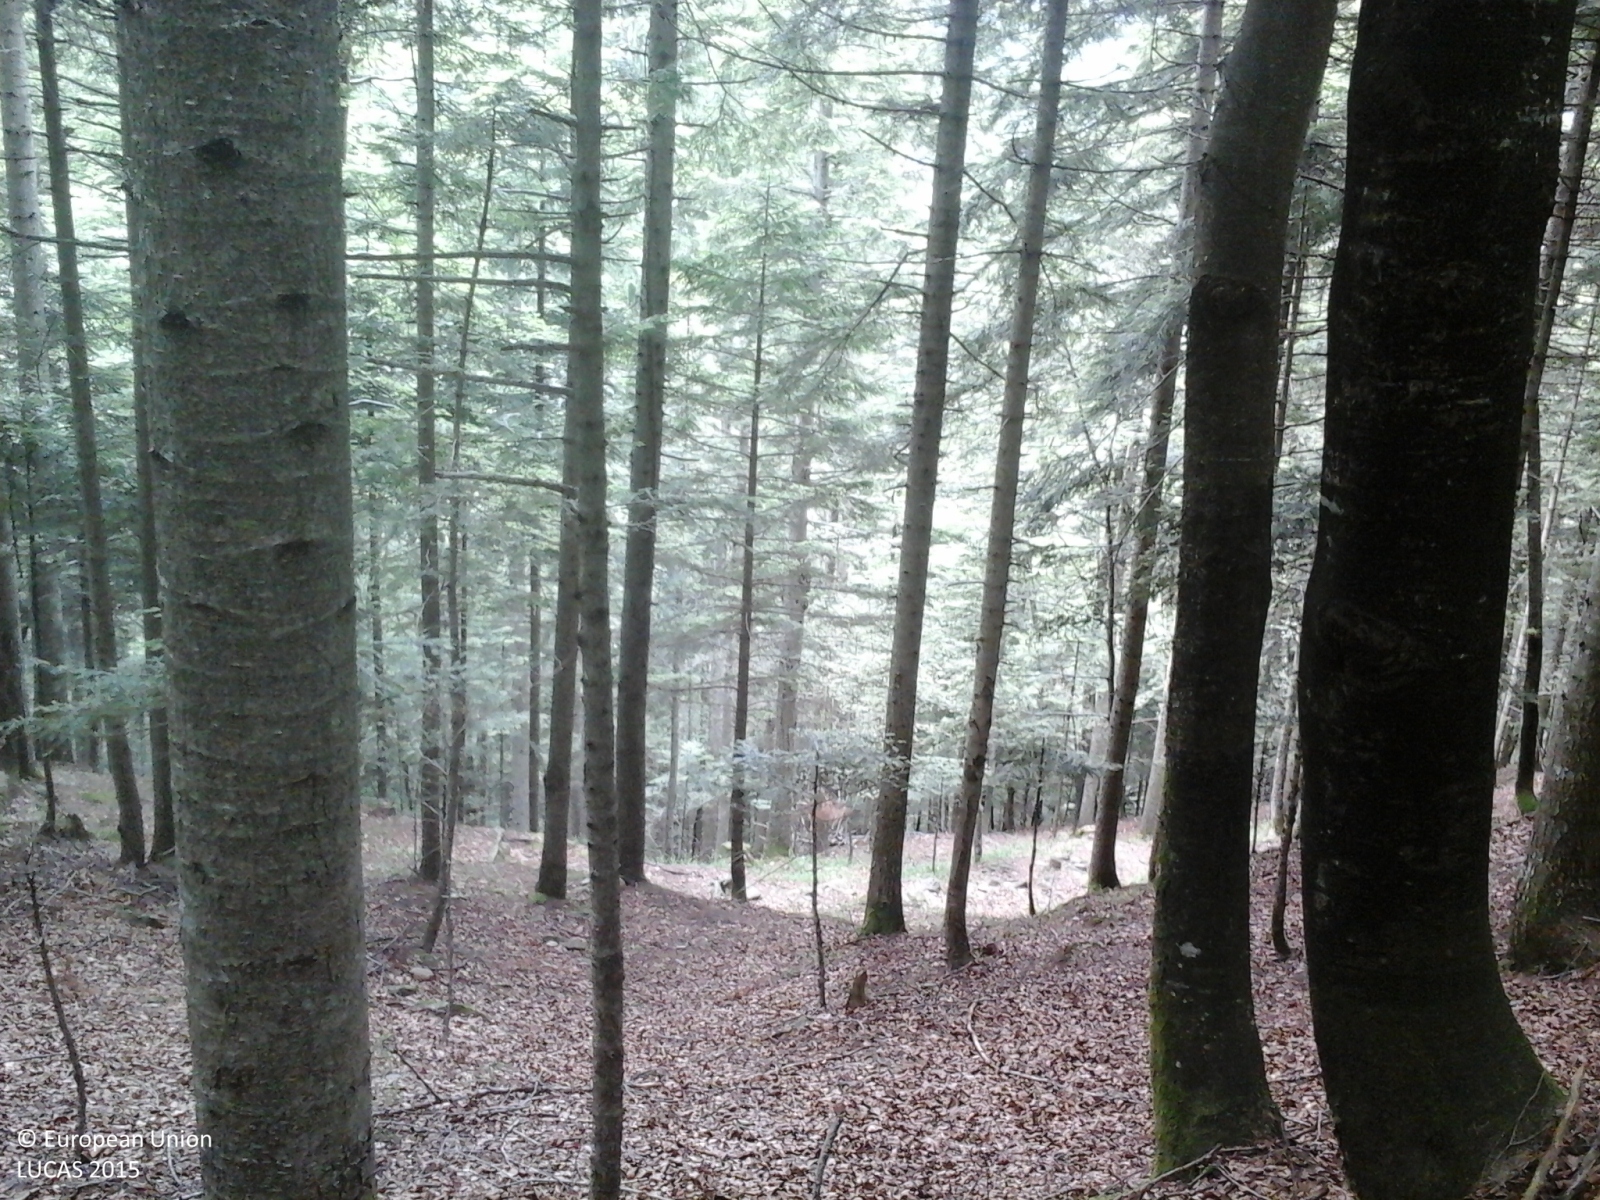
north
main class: Woodland
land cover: Other mixed woodland
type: mountainous beech forest
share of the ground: > 75 %
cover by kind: broadleaved forest trees 75 %, coniferous forest trees 25 %
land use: Forestry
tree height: > 5 m
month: June
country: IT
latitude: 46.1236
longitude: 8.4362
